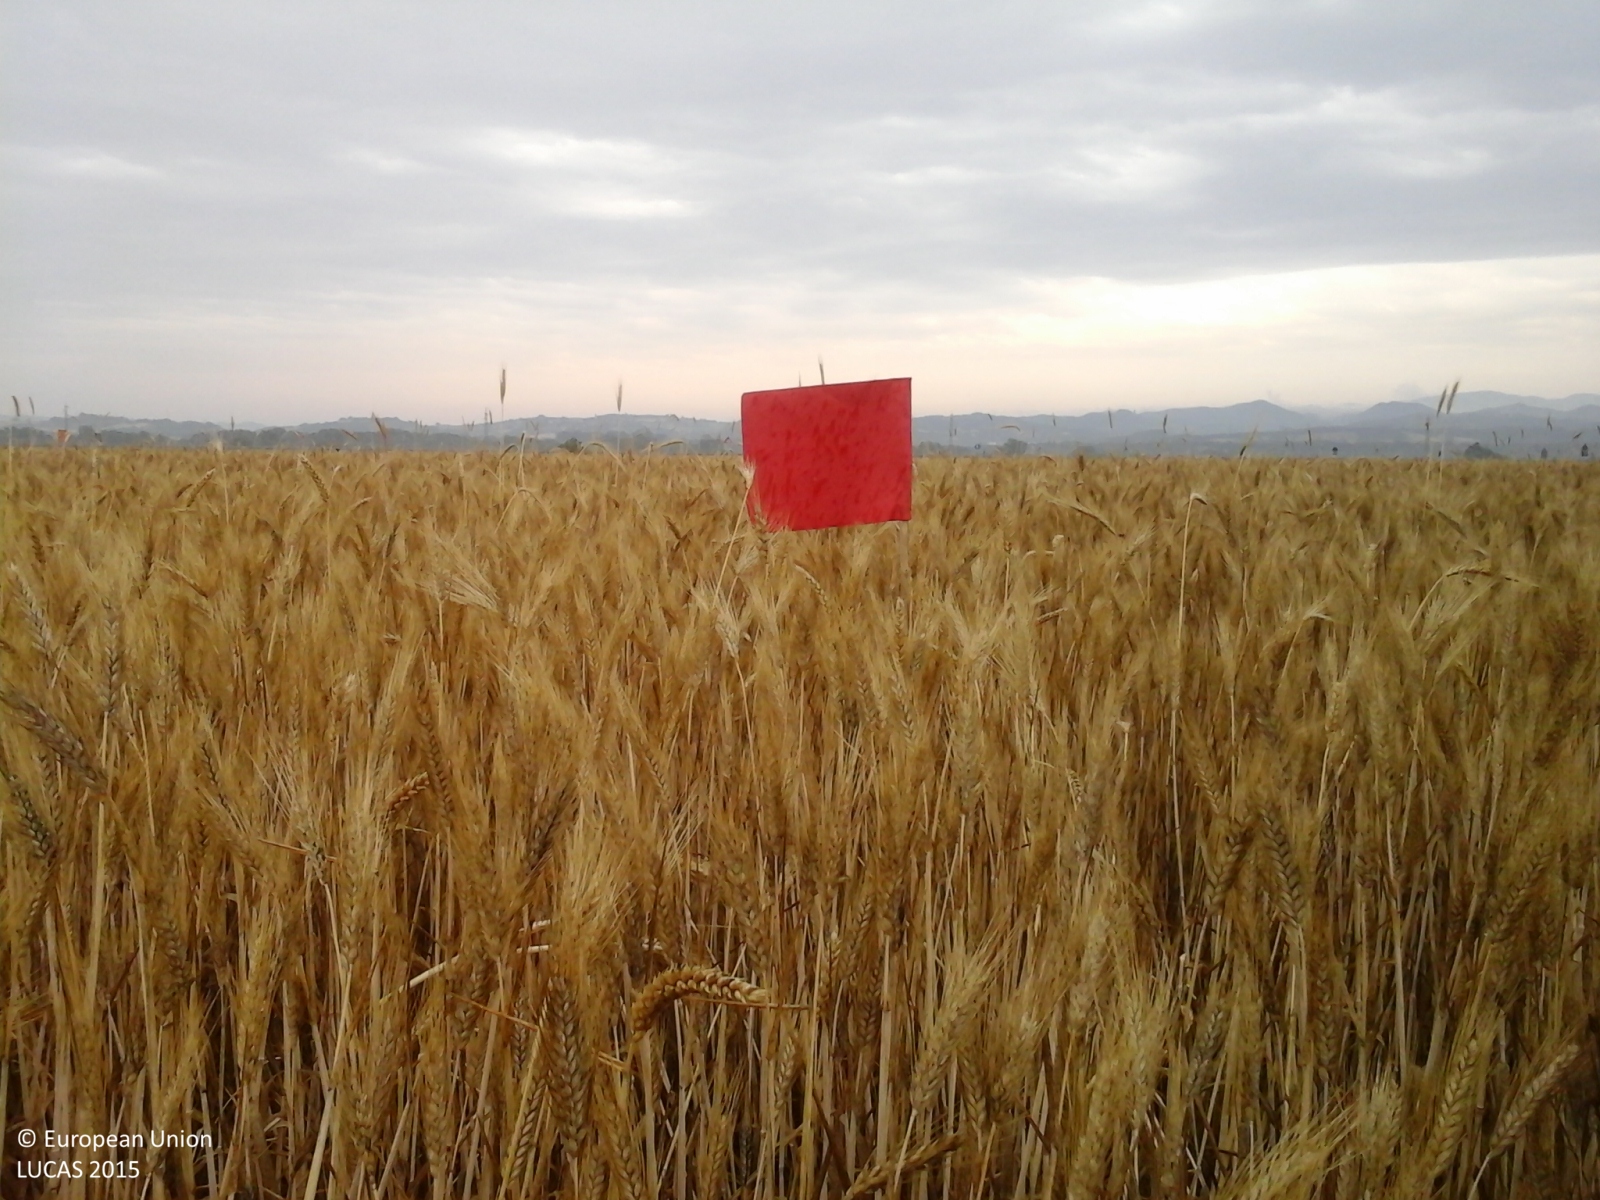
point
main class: Cropland
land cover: Common wheat
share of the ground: > 75 %
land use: Agriculture (excluding fallow land and kitchen gardens)
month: June
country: IT
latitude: 44.8128
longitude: 8.8264
